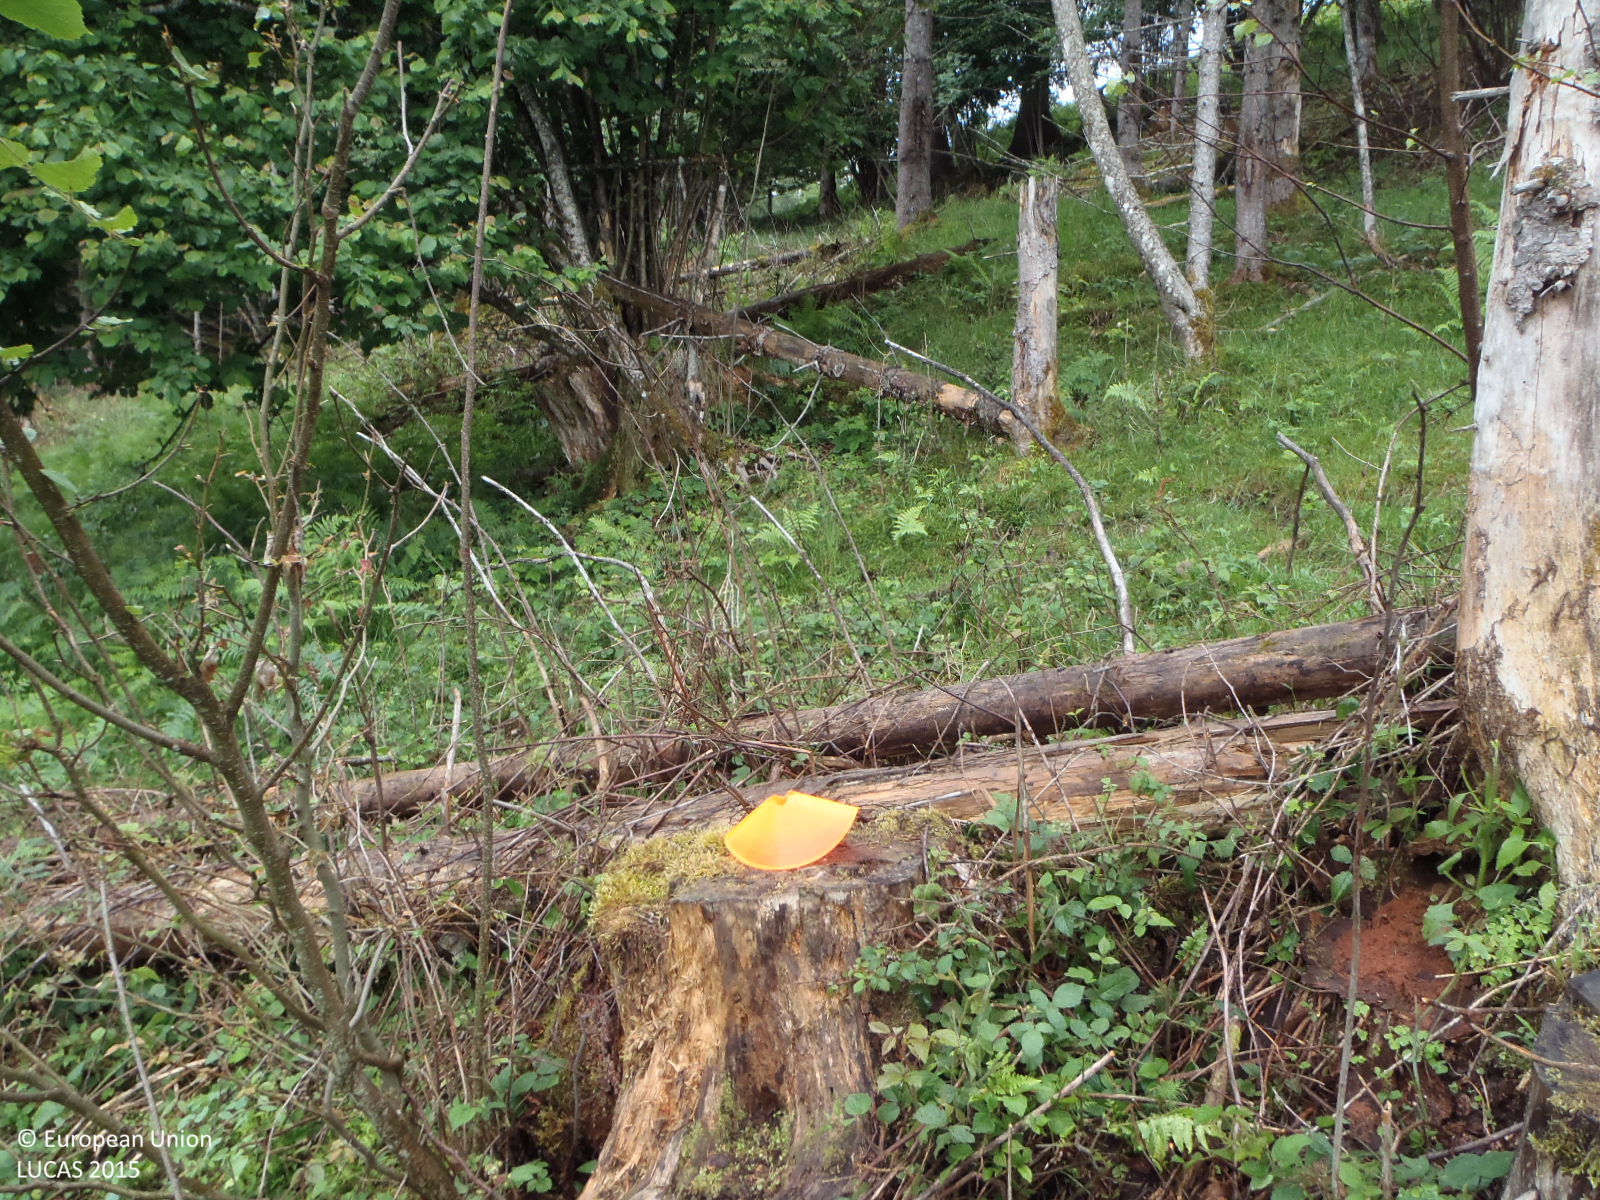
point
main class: Shrubland
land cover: Shrubland with sparse tree cover
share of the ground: > 75 %
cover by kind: shrubs 60 %, herbaceous plants 35 %, coniferous forest trees 5 %
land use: Forestry
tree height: < 5 m
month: June
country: AT
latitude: 47.3598
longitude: 12.7918
